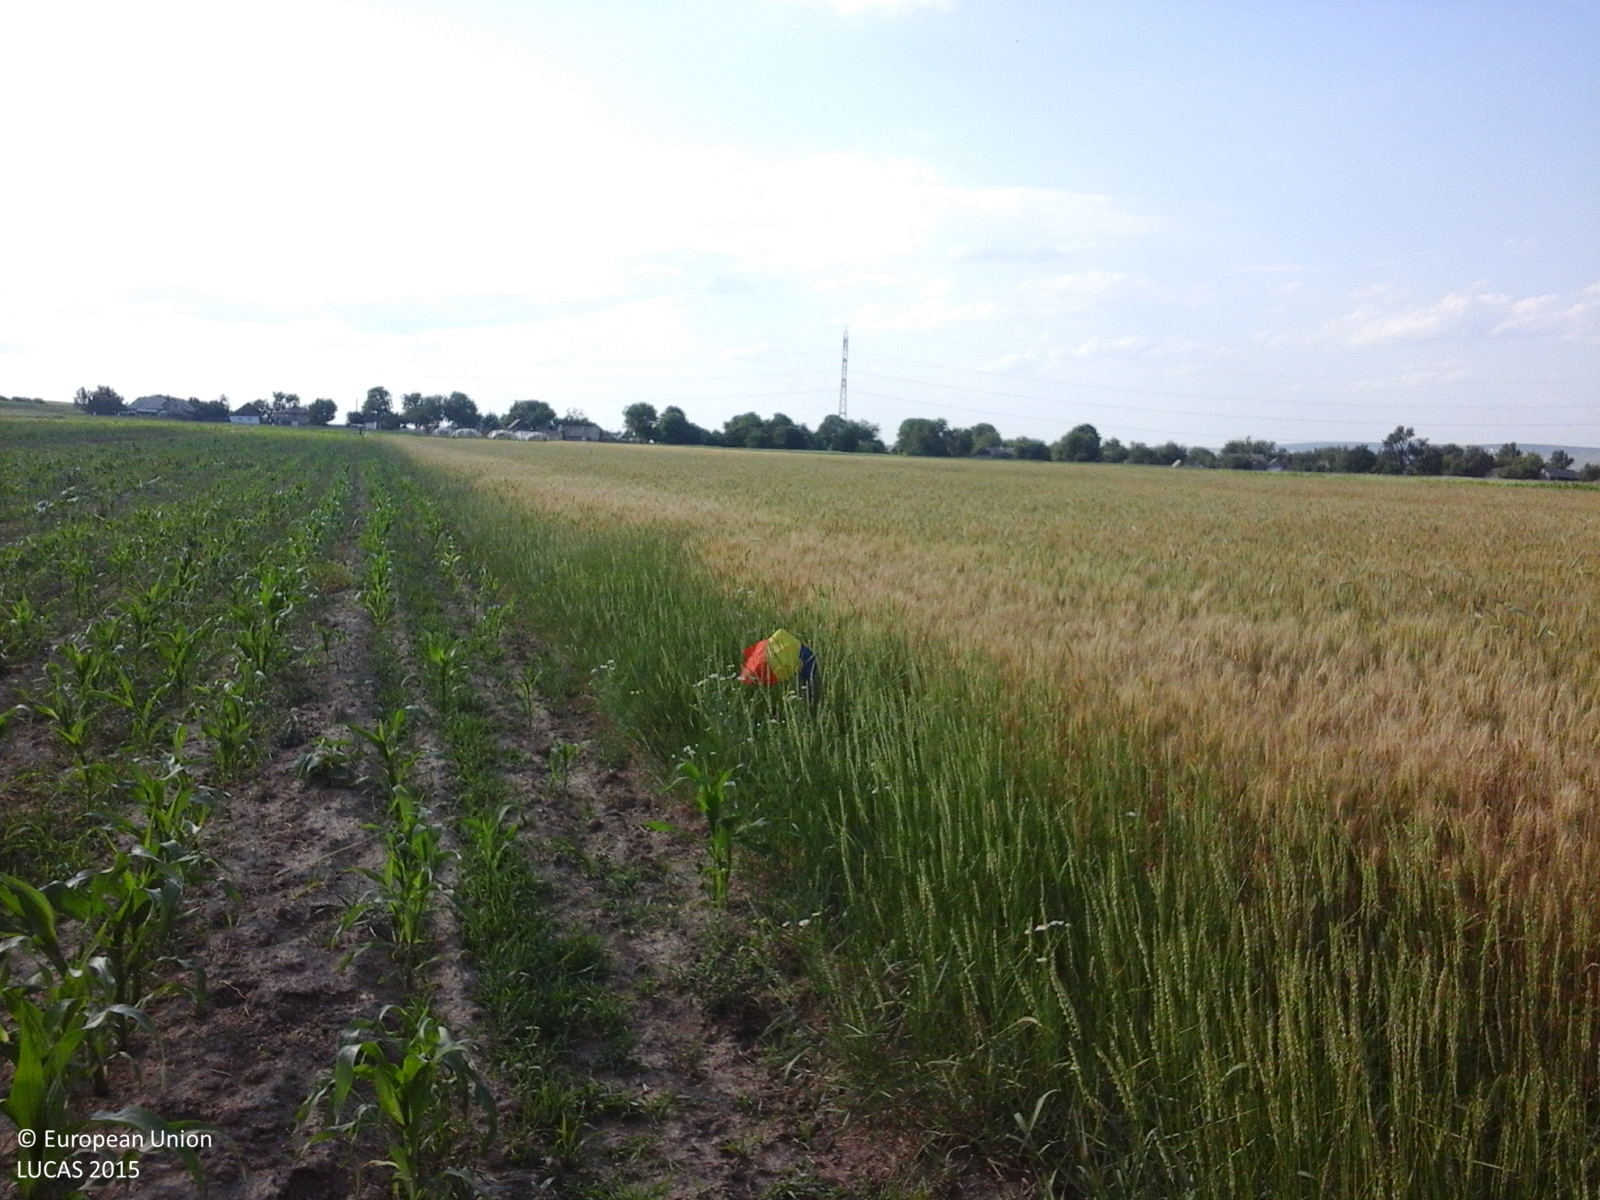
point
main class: Cropland
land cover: Common wheat
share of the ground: > 75 %
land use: Agriculture (excluding fallow land and kitchen gardens)
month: June
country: RO
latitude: 47.7414
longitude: 26.3705
